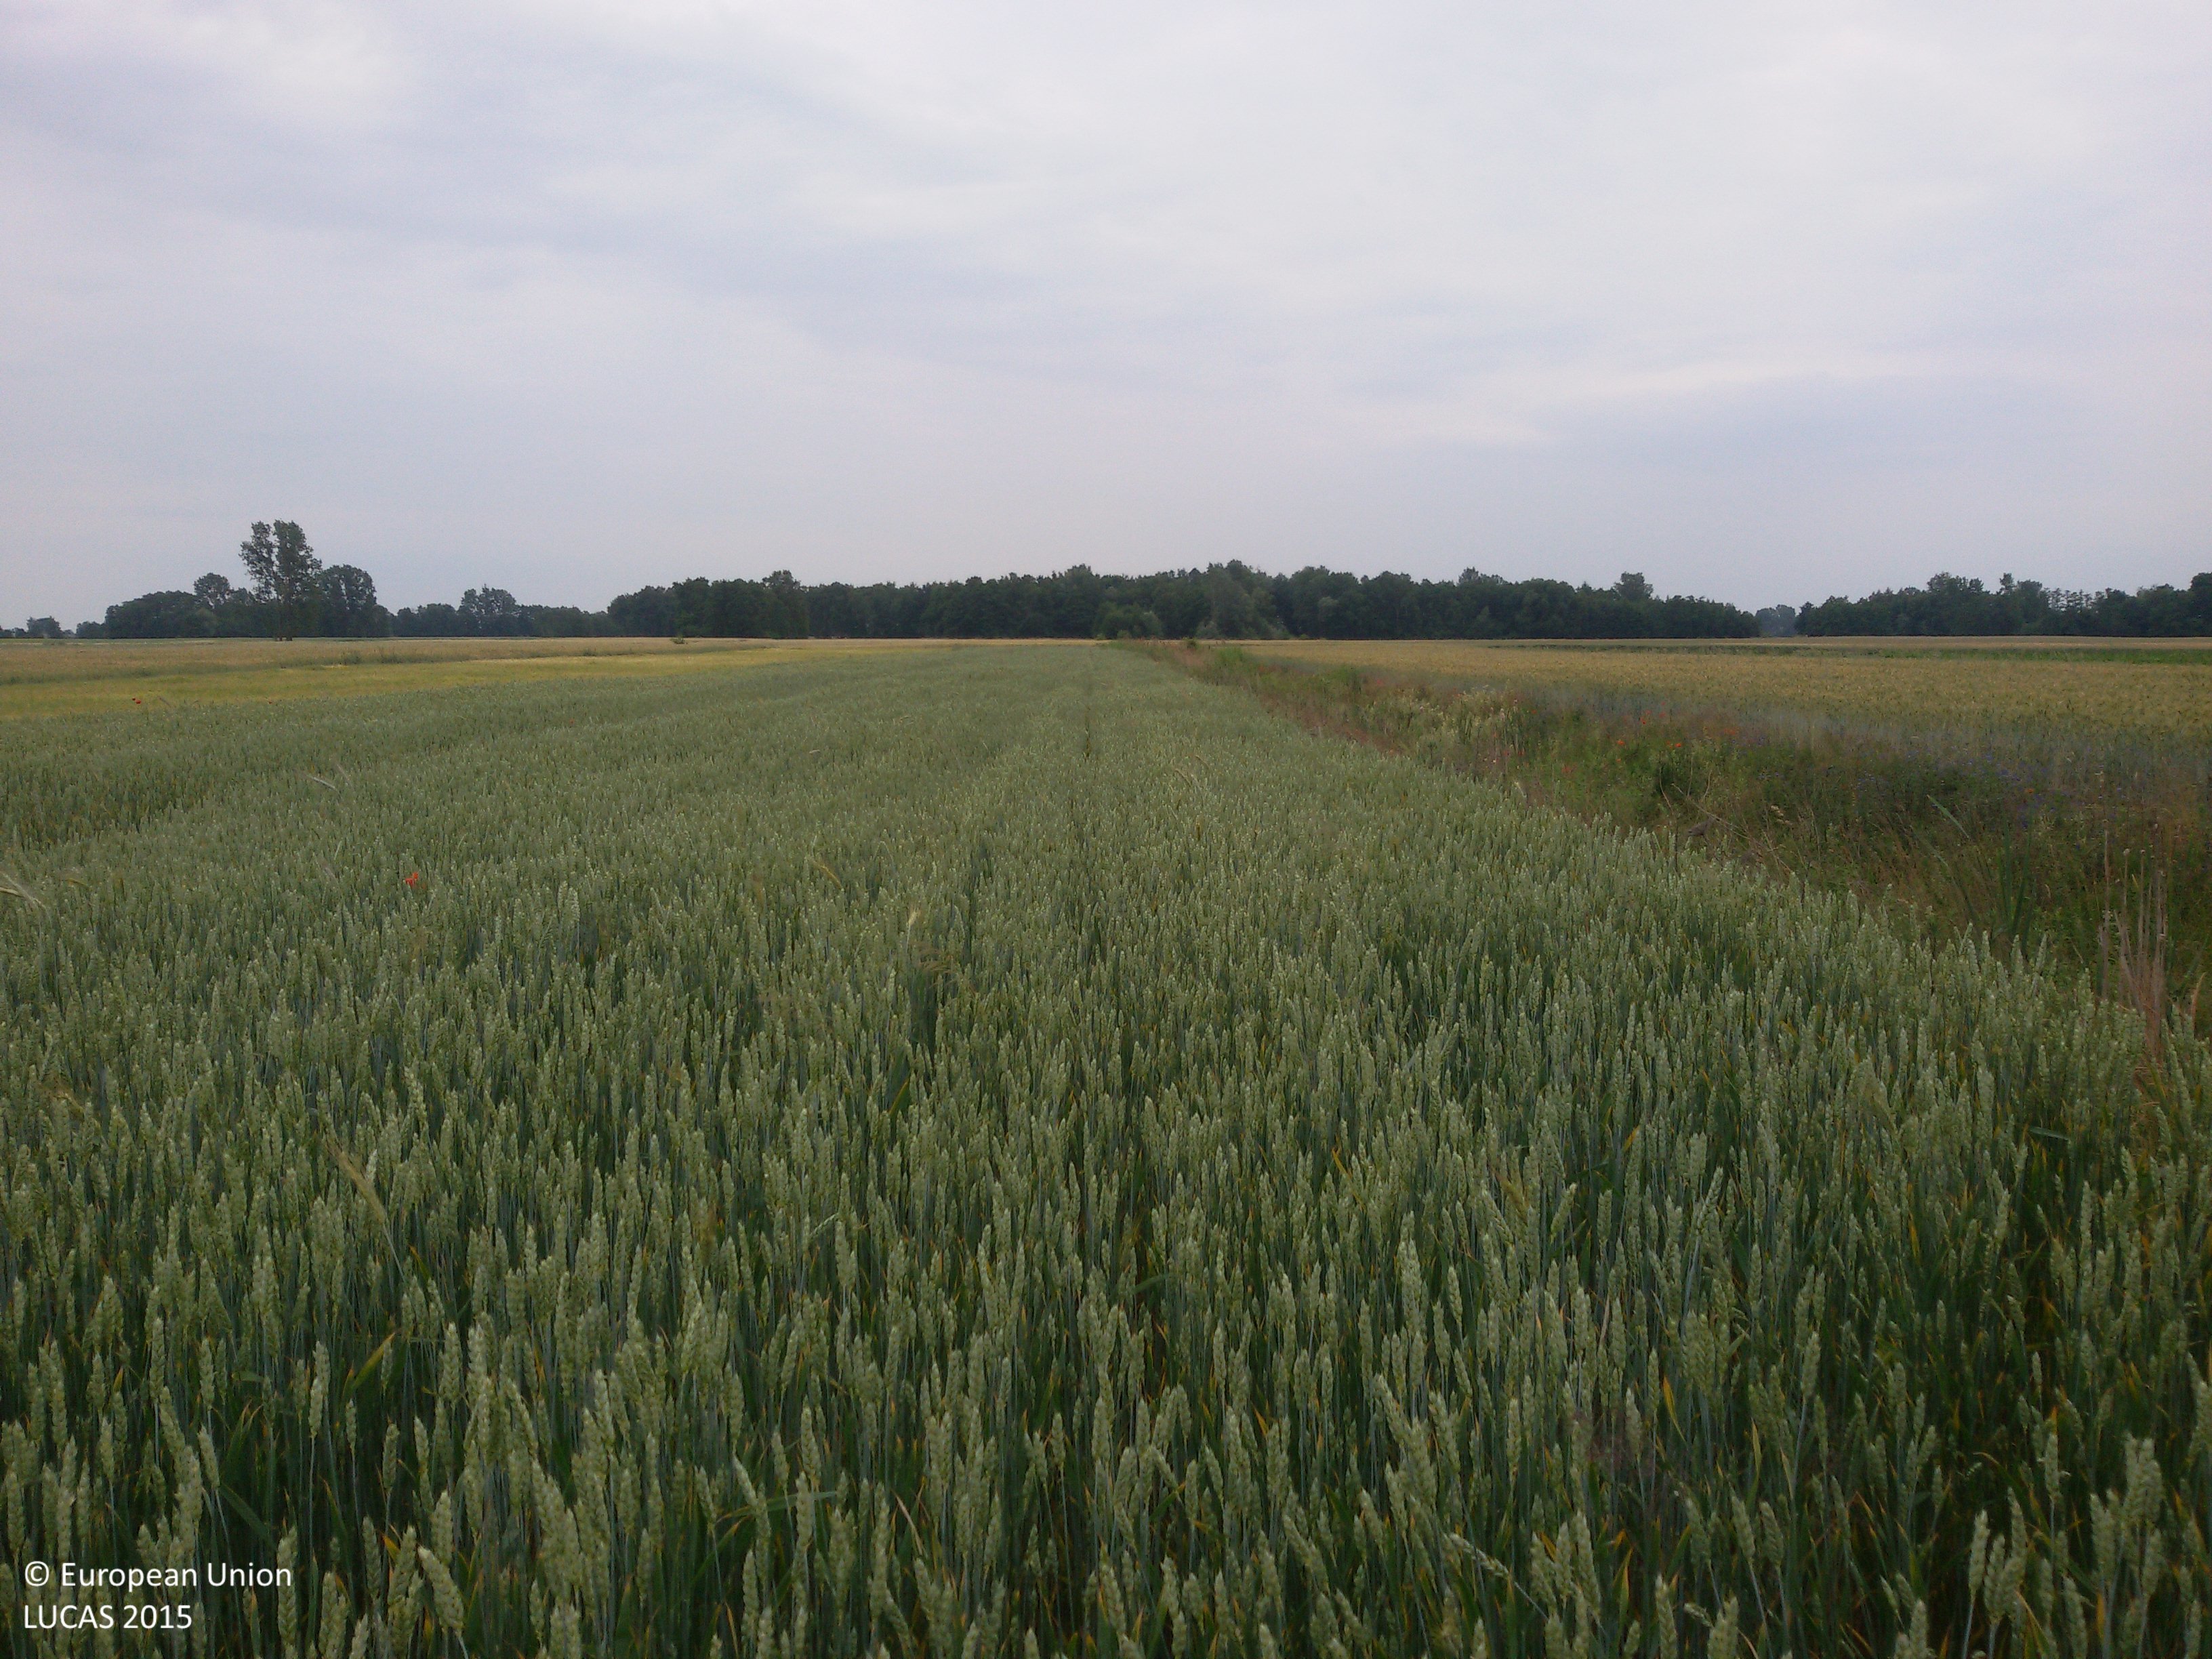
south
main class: Cropland
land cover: Common wheat
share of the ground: > 75 %
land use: Agriculture (excluding fallow land and kitchen gardens)
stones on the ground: 10 - 25 %
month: June
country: PL
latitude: 52.2129
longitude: 19.9403
